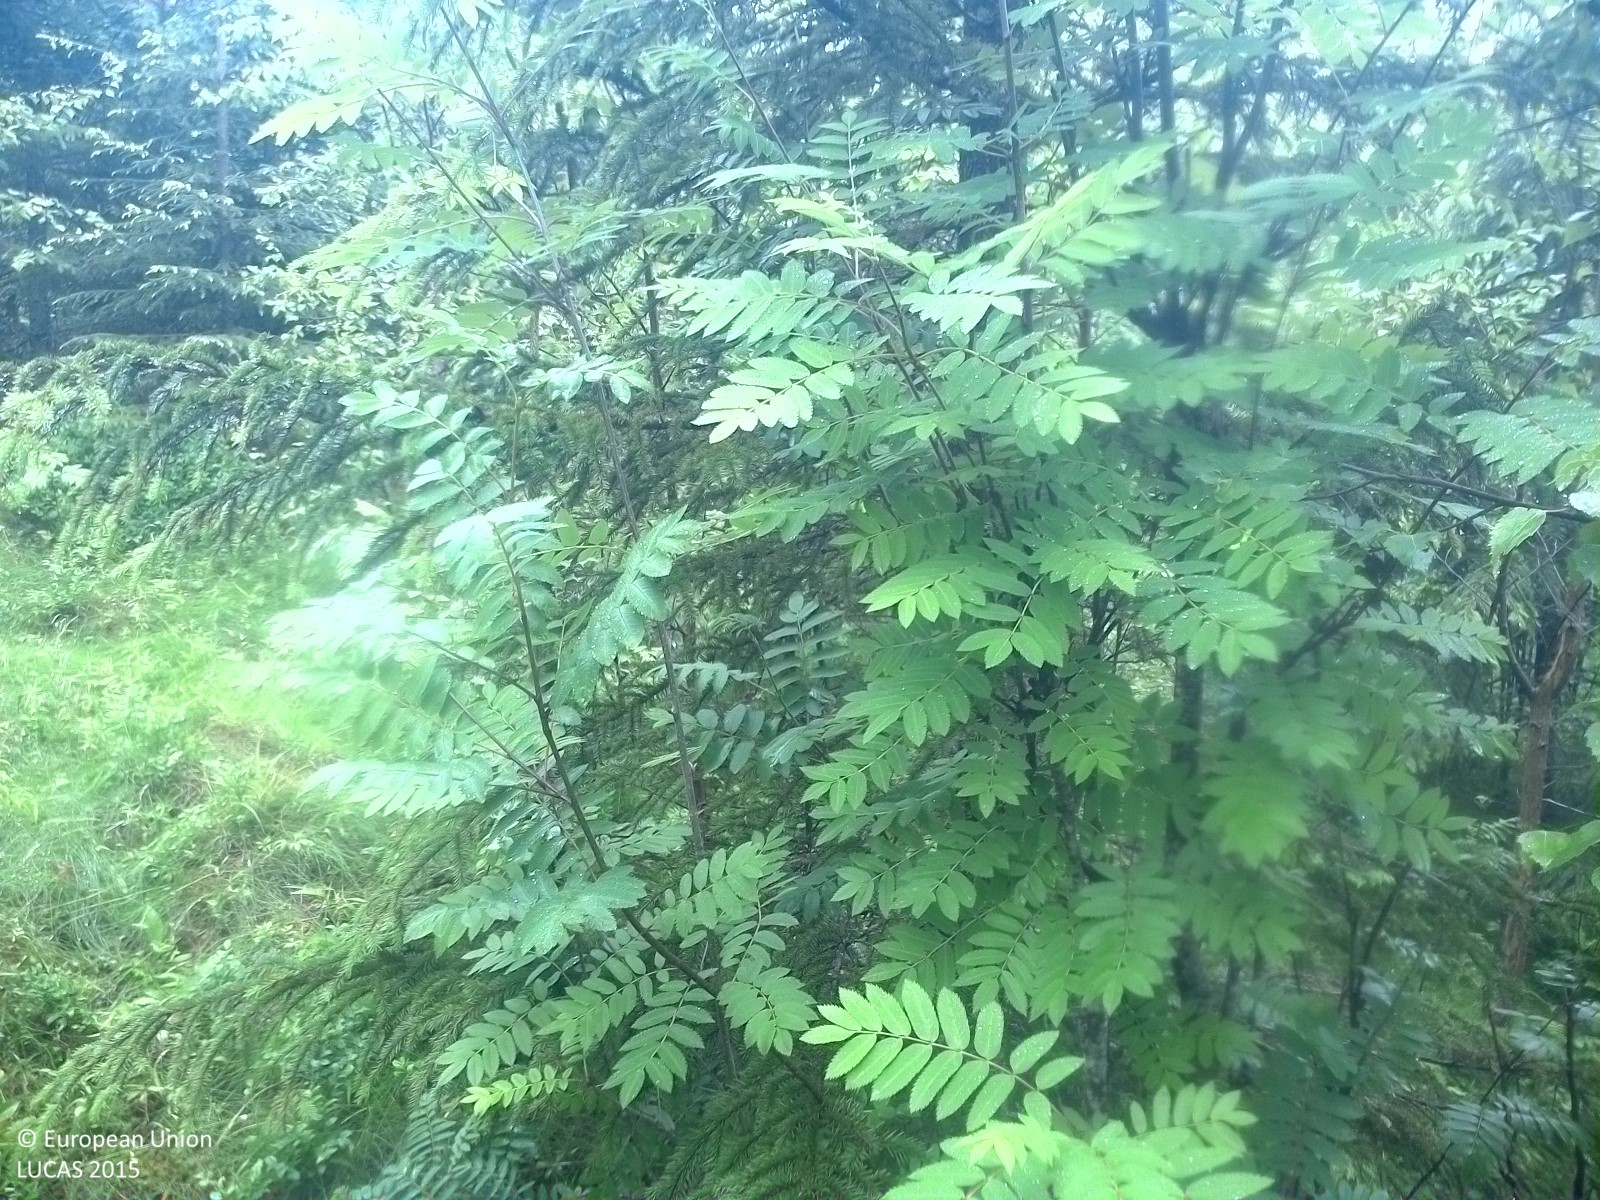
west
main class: Woodland
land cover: Spruce dominated mixed woodland
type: boreal forest
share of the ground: 50 - 75 %
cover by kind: coniferous forest trees 45 %, broadleaved forest trees 30 %, herbaceous plants 25 %
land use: Forestry
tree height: > 5 m
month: July
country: SE
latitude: 62.5062
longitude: 16.9499
